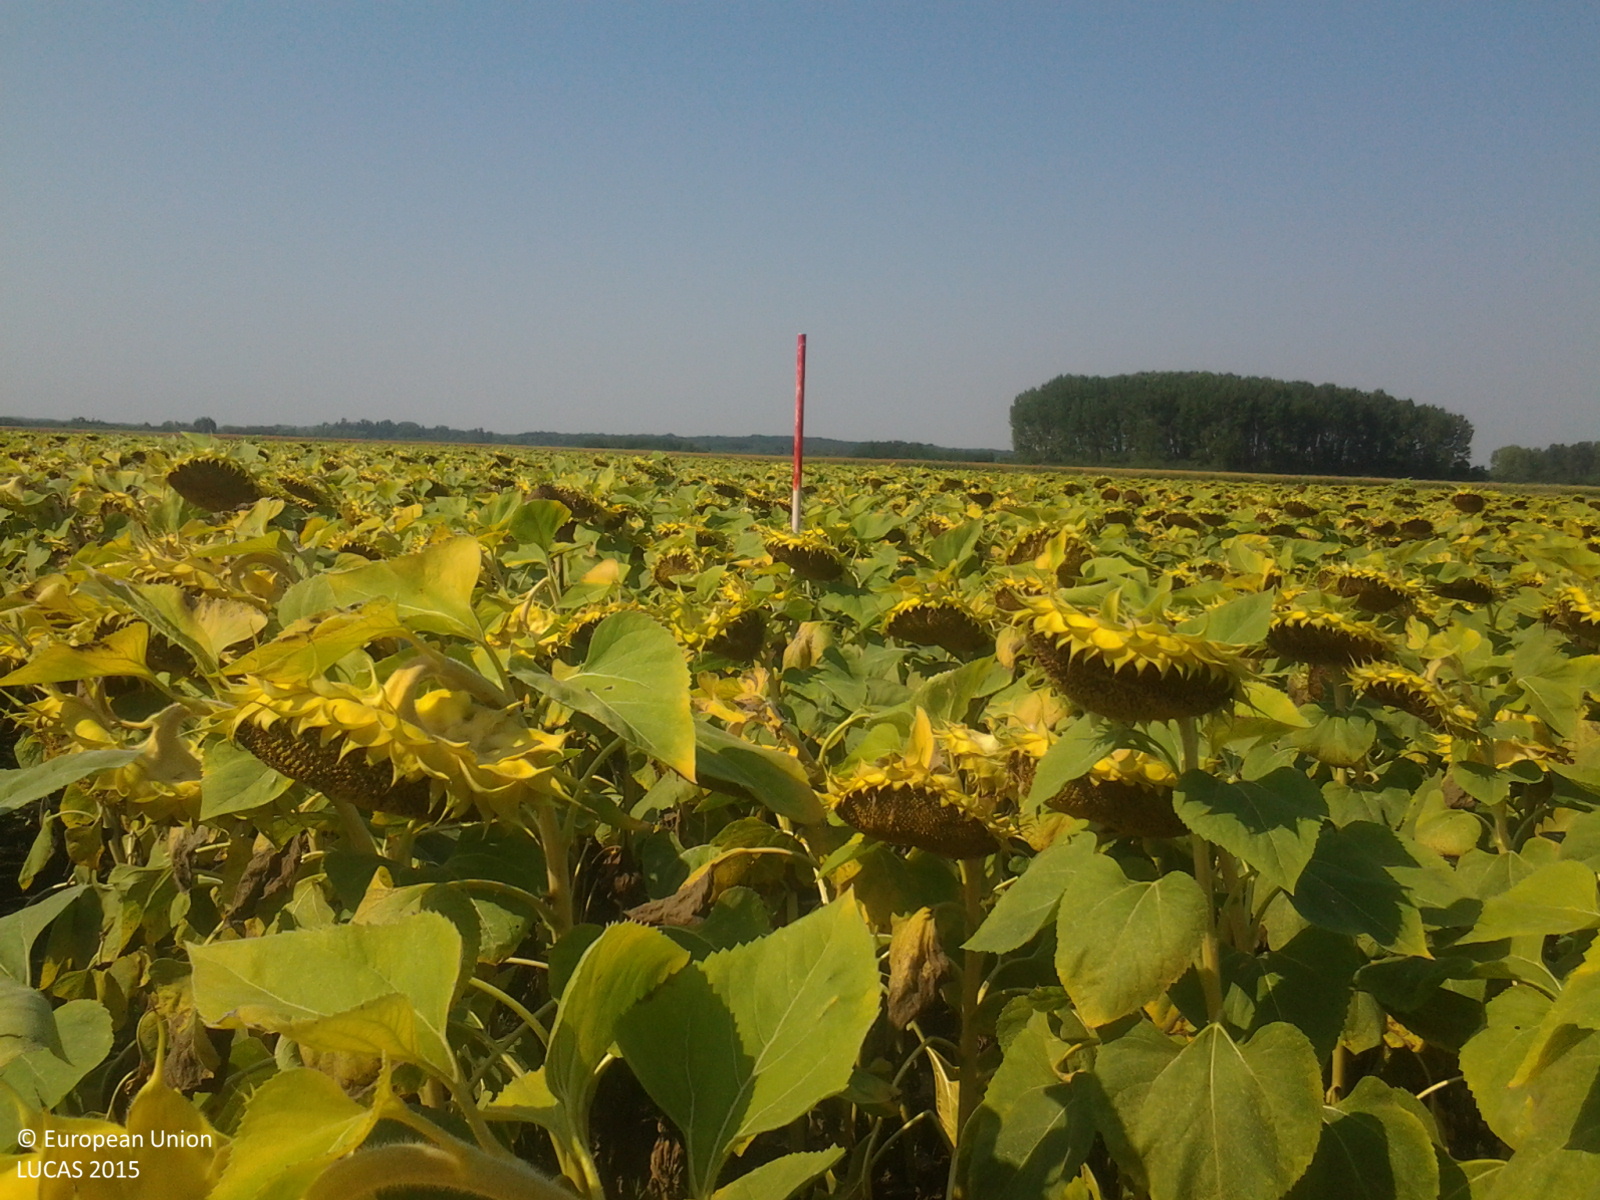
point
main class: Cropland
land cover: Sunflower
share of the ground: > 75 %
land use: Agriculture (excluding fallow land and kitchen gardens)
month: August
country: HU
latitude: 46.9051
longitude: 21.2082
